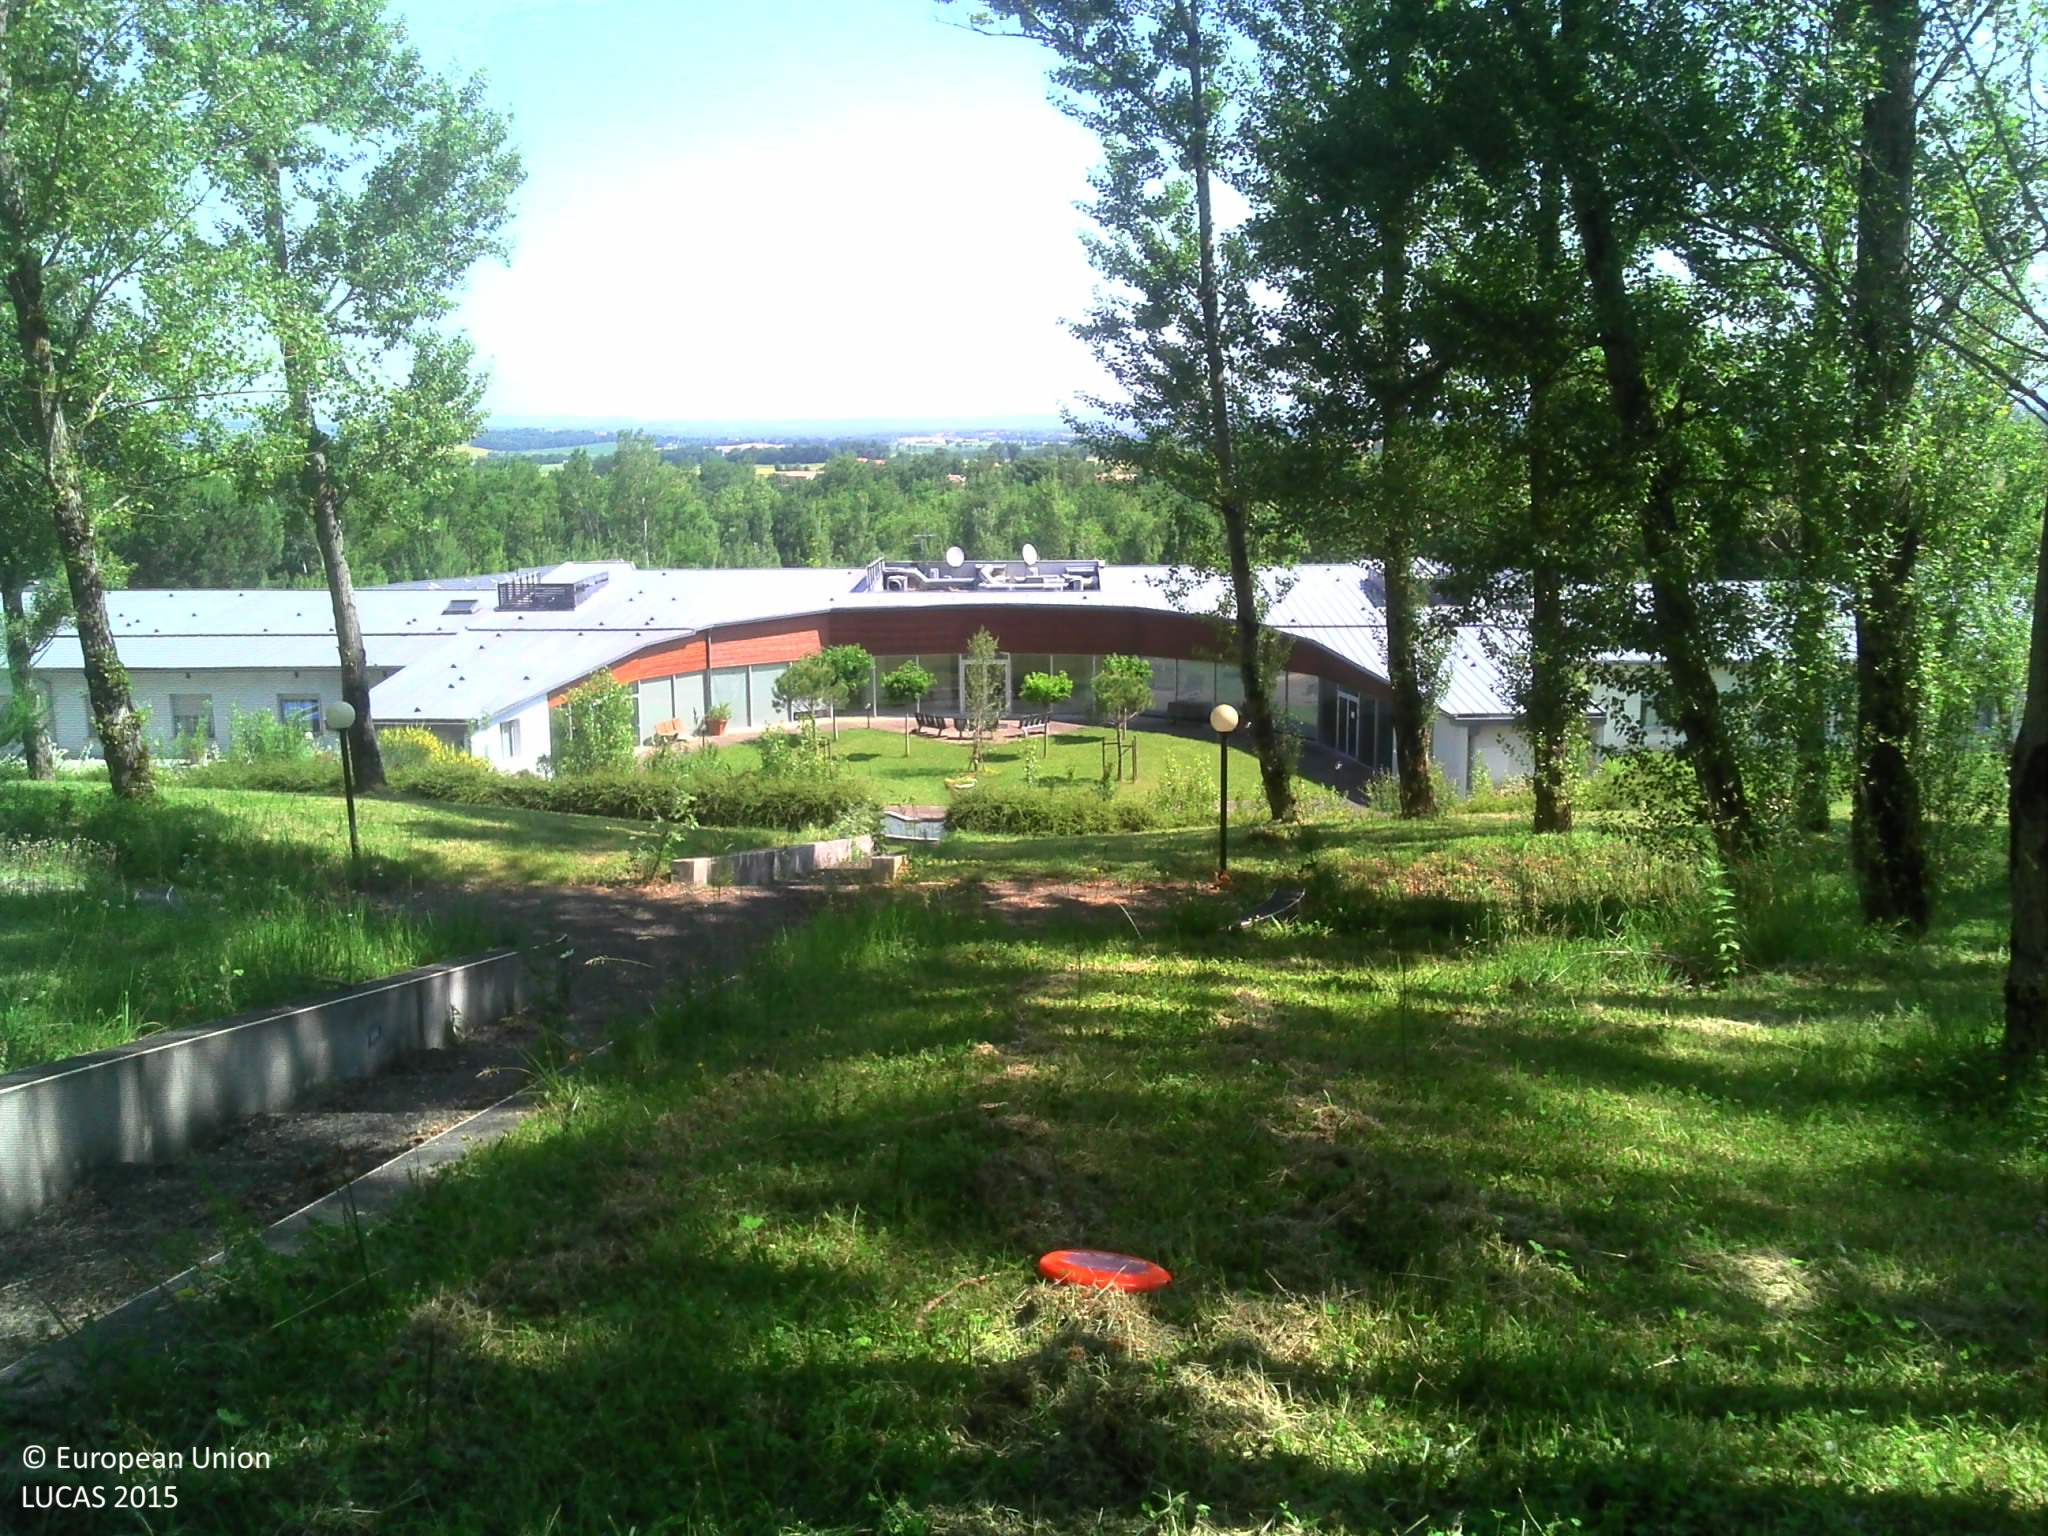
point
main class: Woodland
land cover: Broadleaved woodland
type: mesophytic deciduous forest
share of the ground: 50 - 75 %
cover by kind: broadleaved forest trees 65 %, herbaceous plants 35 %
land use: Residential
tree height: > 5 m
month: June
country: FR
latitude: 43.4679
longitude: 2.0825
